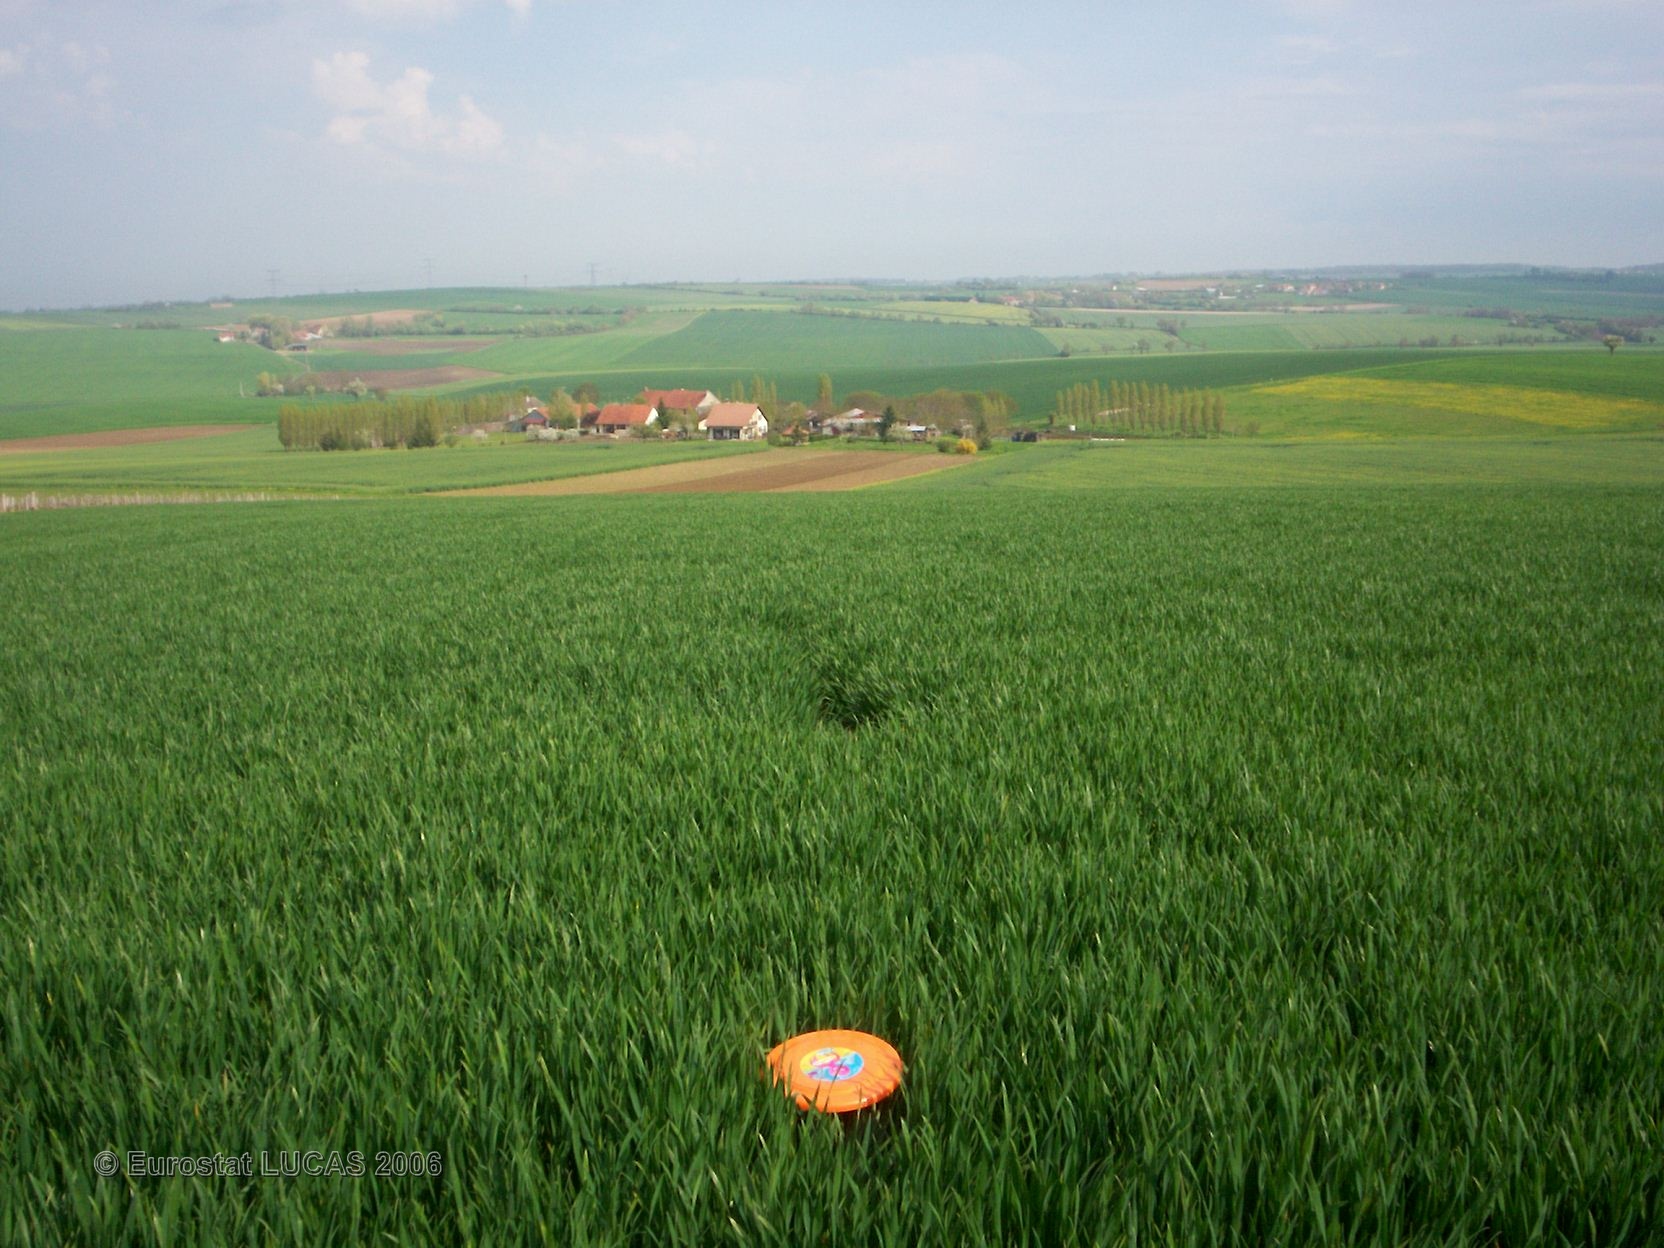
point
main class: Cropland
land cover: Common wheat
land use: Agriculture (excluding fallow land and kitchen gardens)
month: April
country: FR
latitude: 47.4055
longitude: 3.0110
